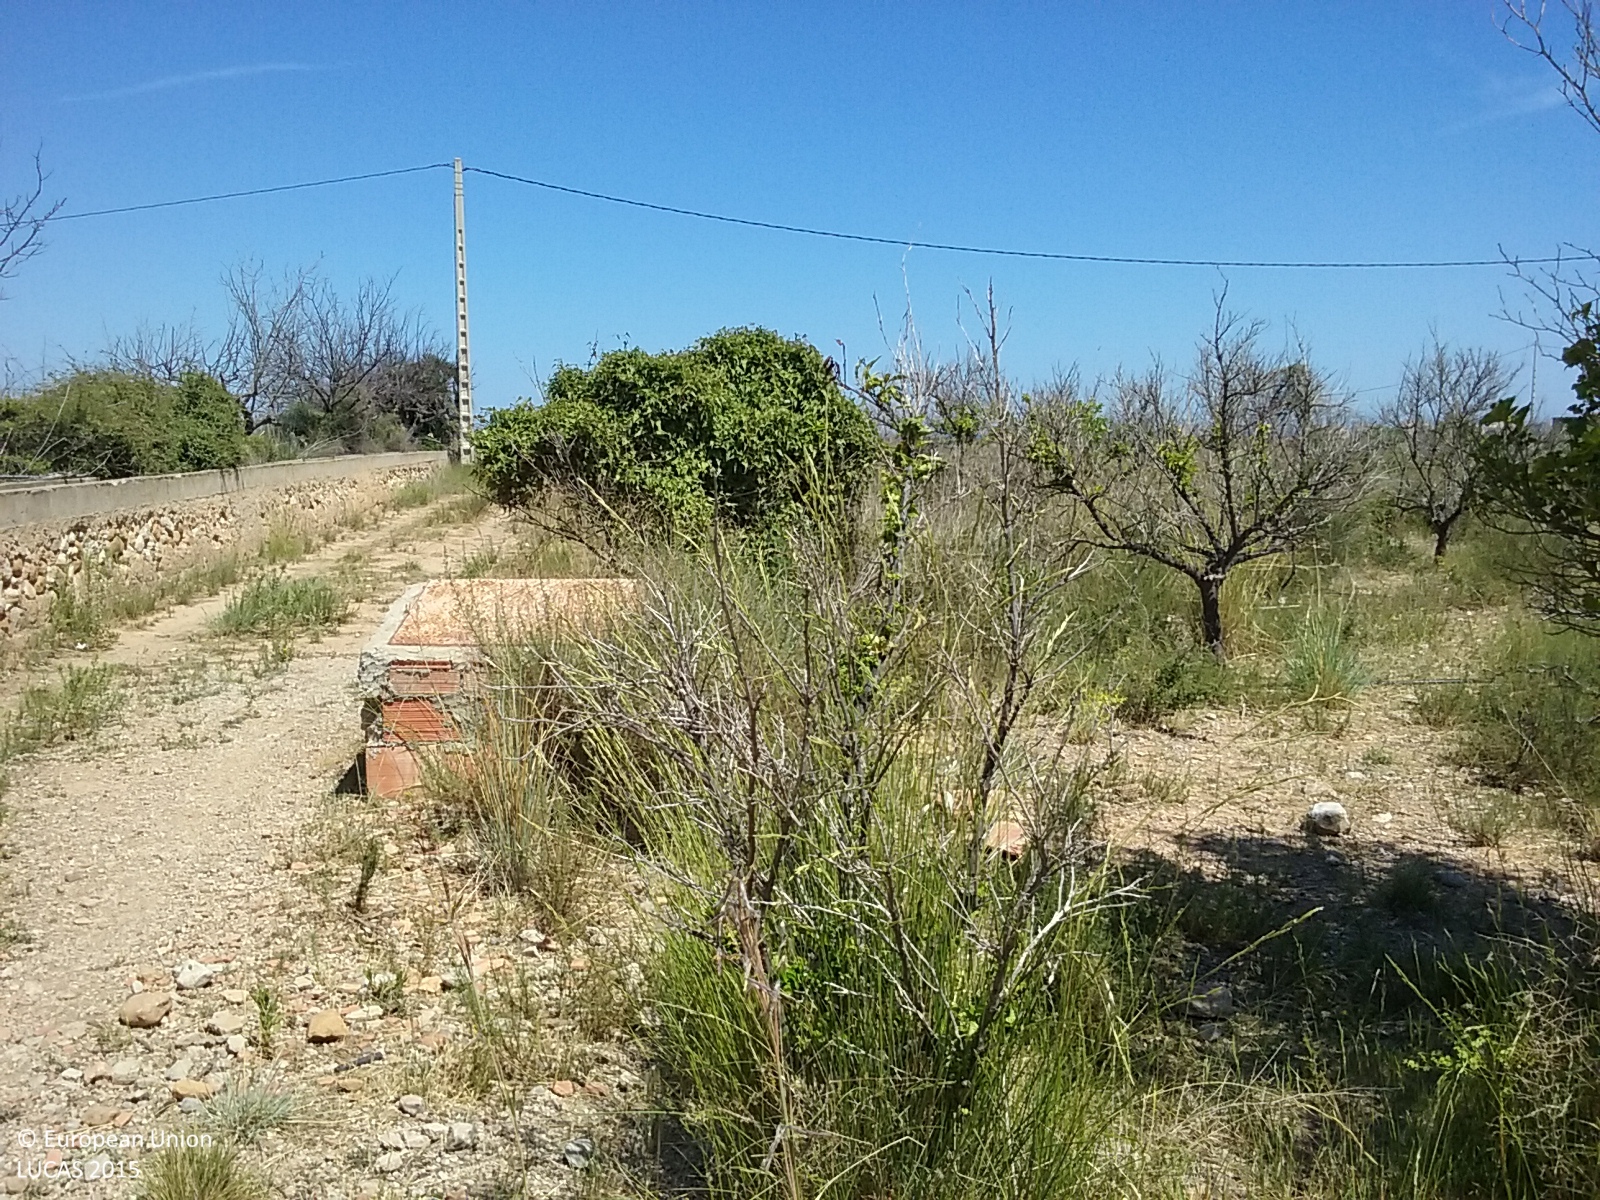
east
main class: Cropland
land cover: Other citrus fruit
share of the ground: < 10 %
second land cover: Grassland without tree/shrub cover
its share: 25 - 50 %
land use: Abandoned areas
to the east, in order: Other citrus fruit; Grassland without tree/shrub cover; Electric lines; Other citrus fruit; Electric lines; Other citrus fruit; Ditches and canals; Other citrus fruit; Artificial constructions; Spontaneously vegetated surfaces
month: June
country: ES
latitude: 40.1326
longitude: 0.1283
